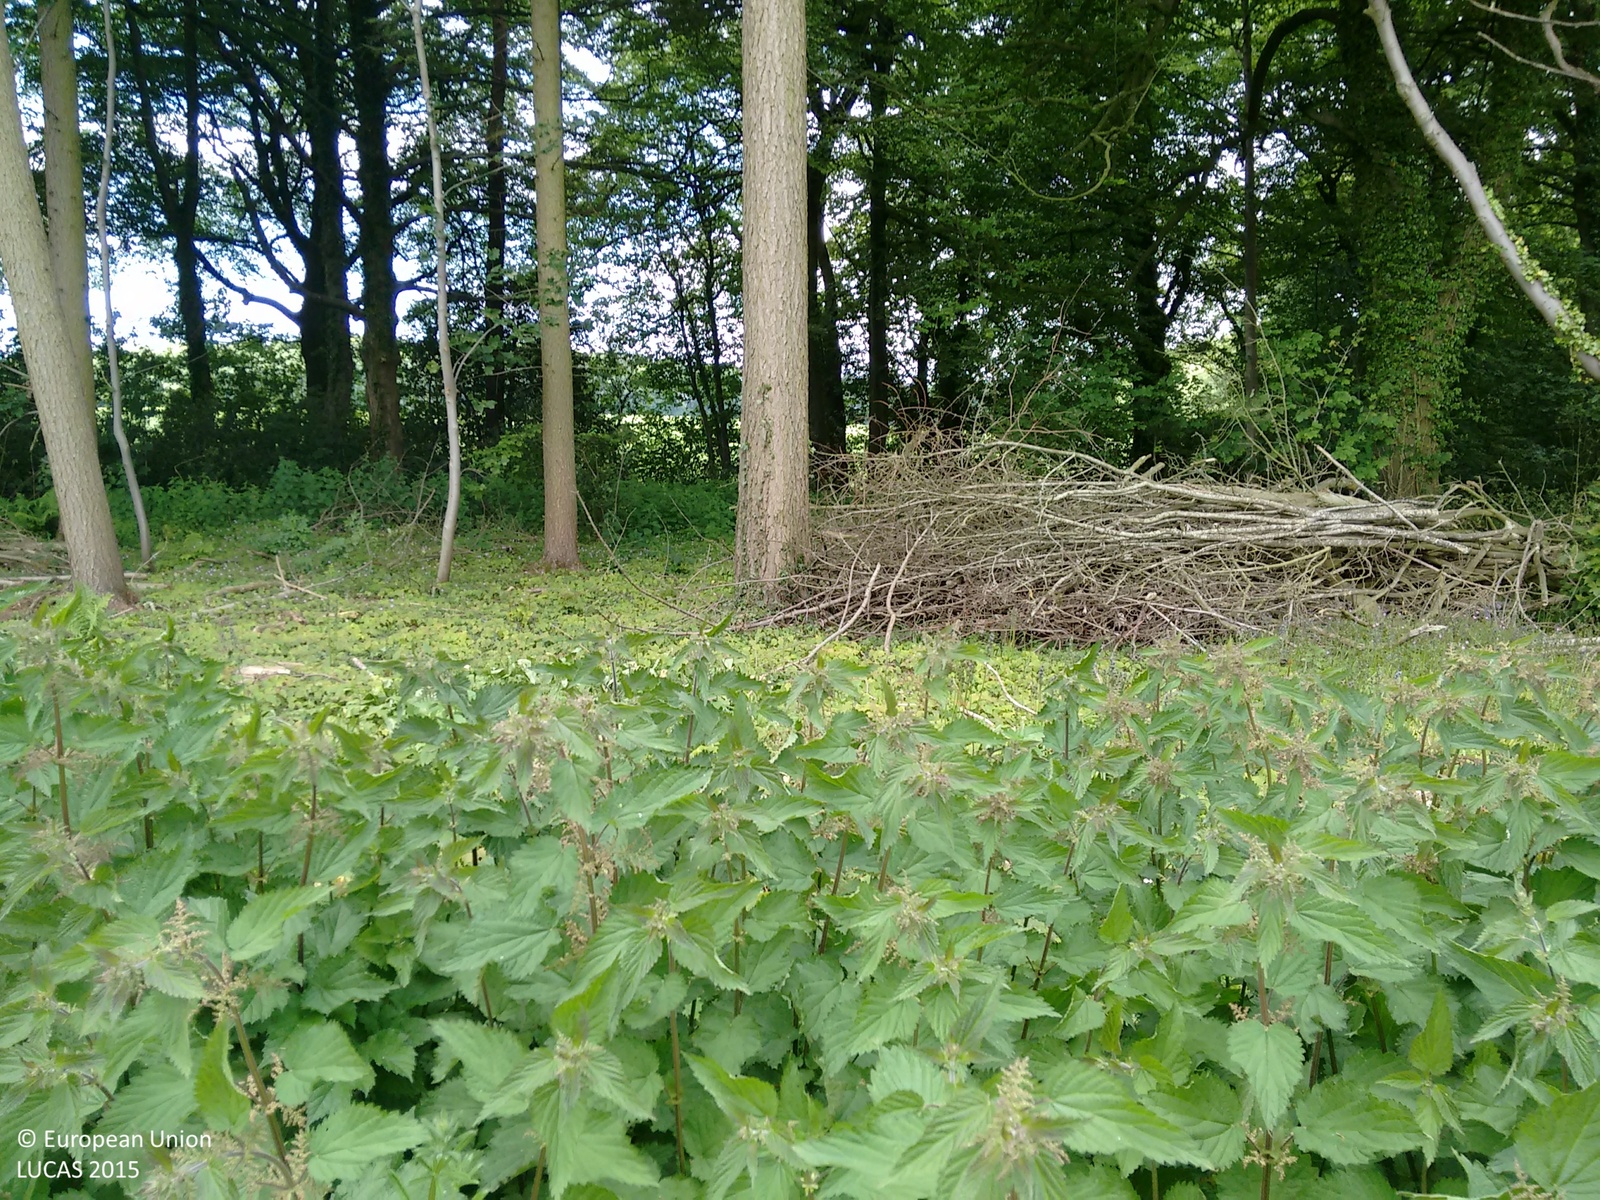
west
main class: Woodland
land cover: Broadleaved woodland
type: mesophytic deciduous forest
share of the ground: > 75 %
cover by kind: broadleaved forest trees 80 %, coniferous forest trees 20 %
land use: Semi-natural and natural areas not in use
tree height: > 5 m
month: June
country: GB
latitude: 51.0628
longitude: -2.1175
